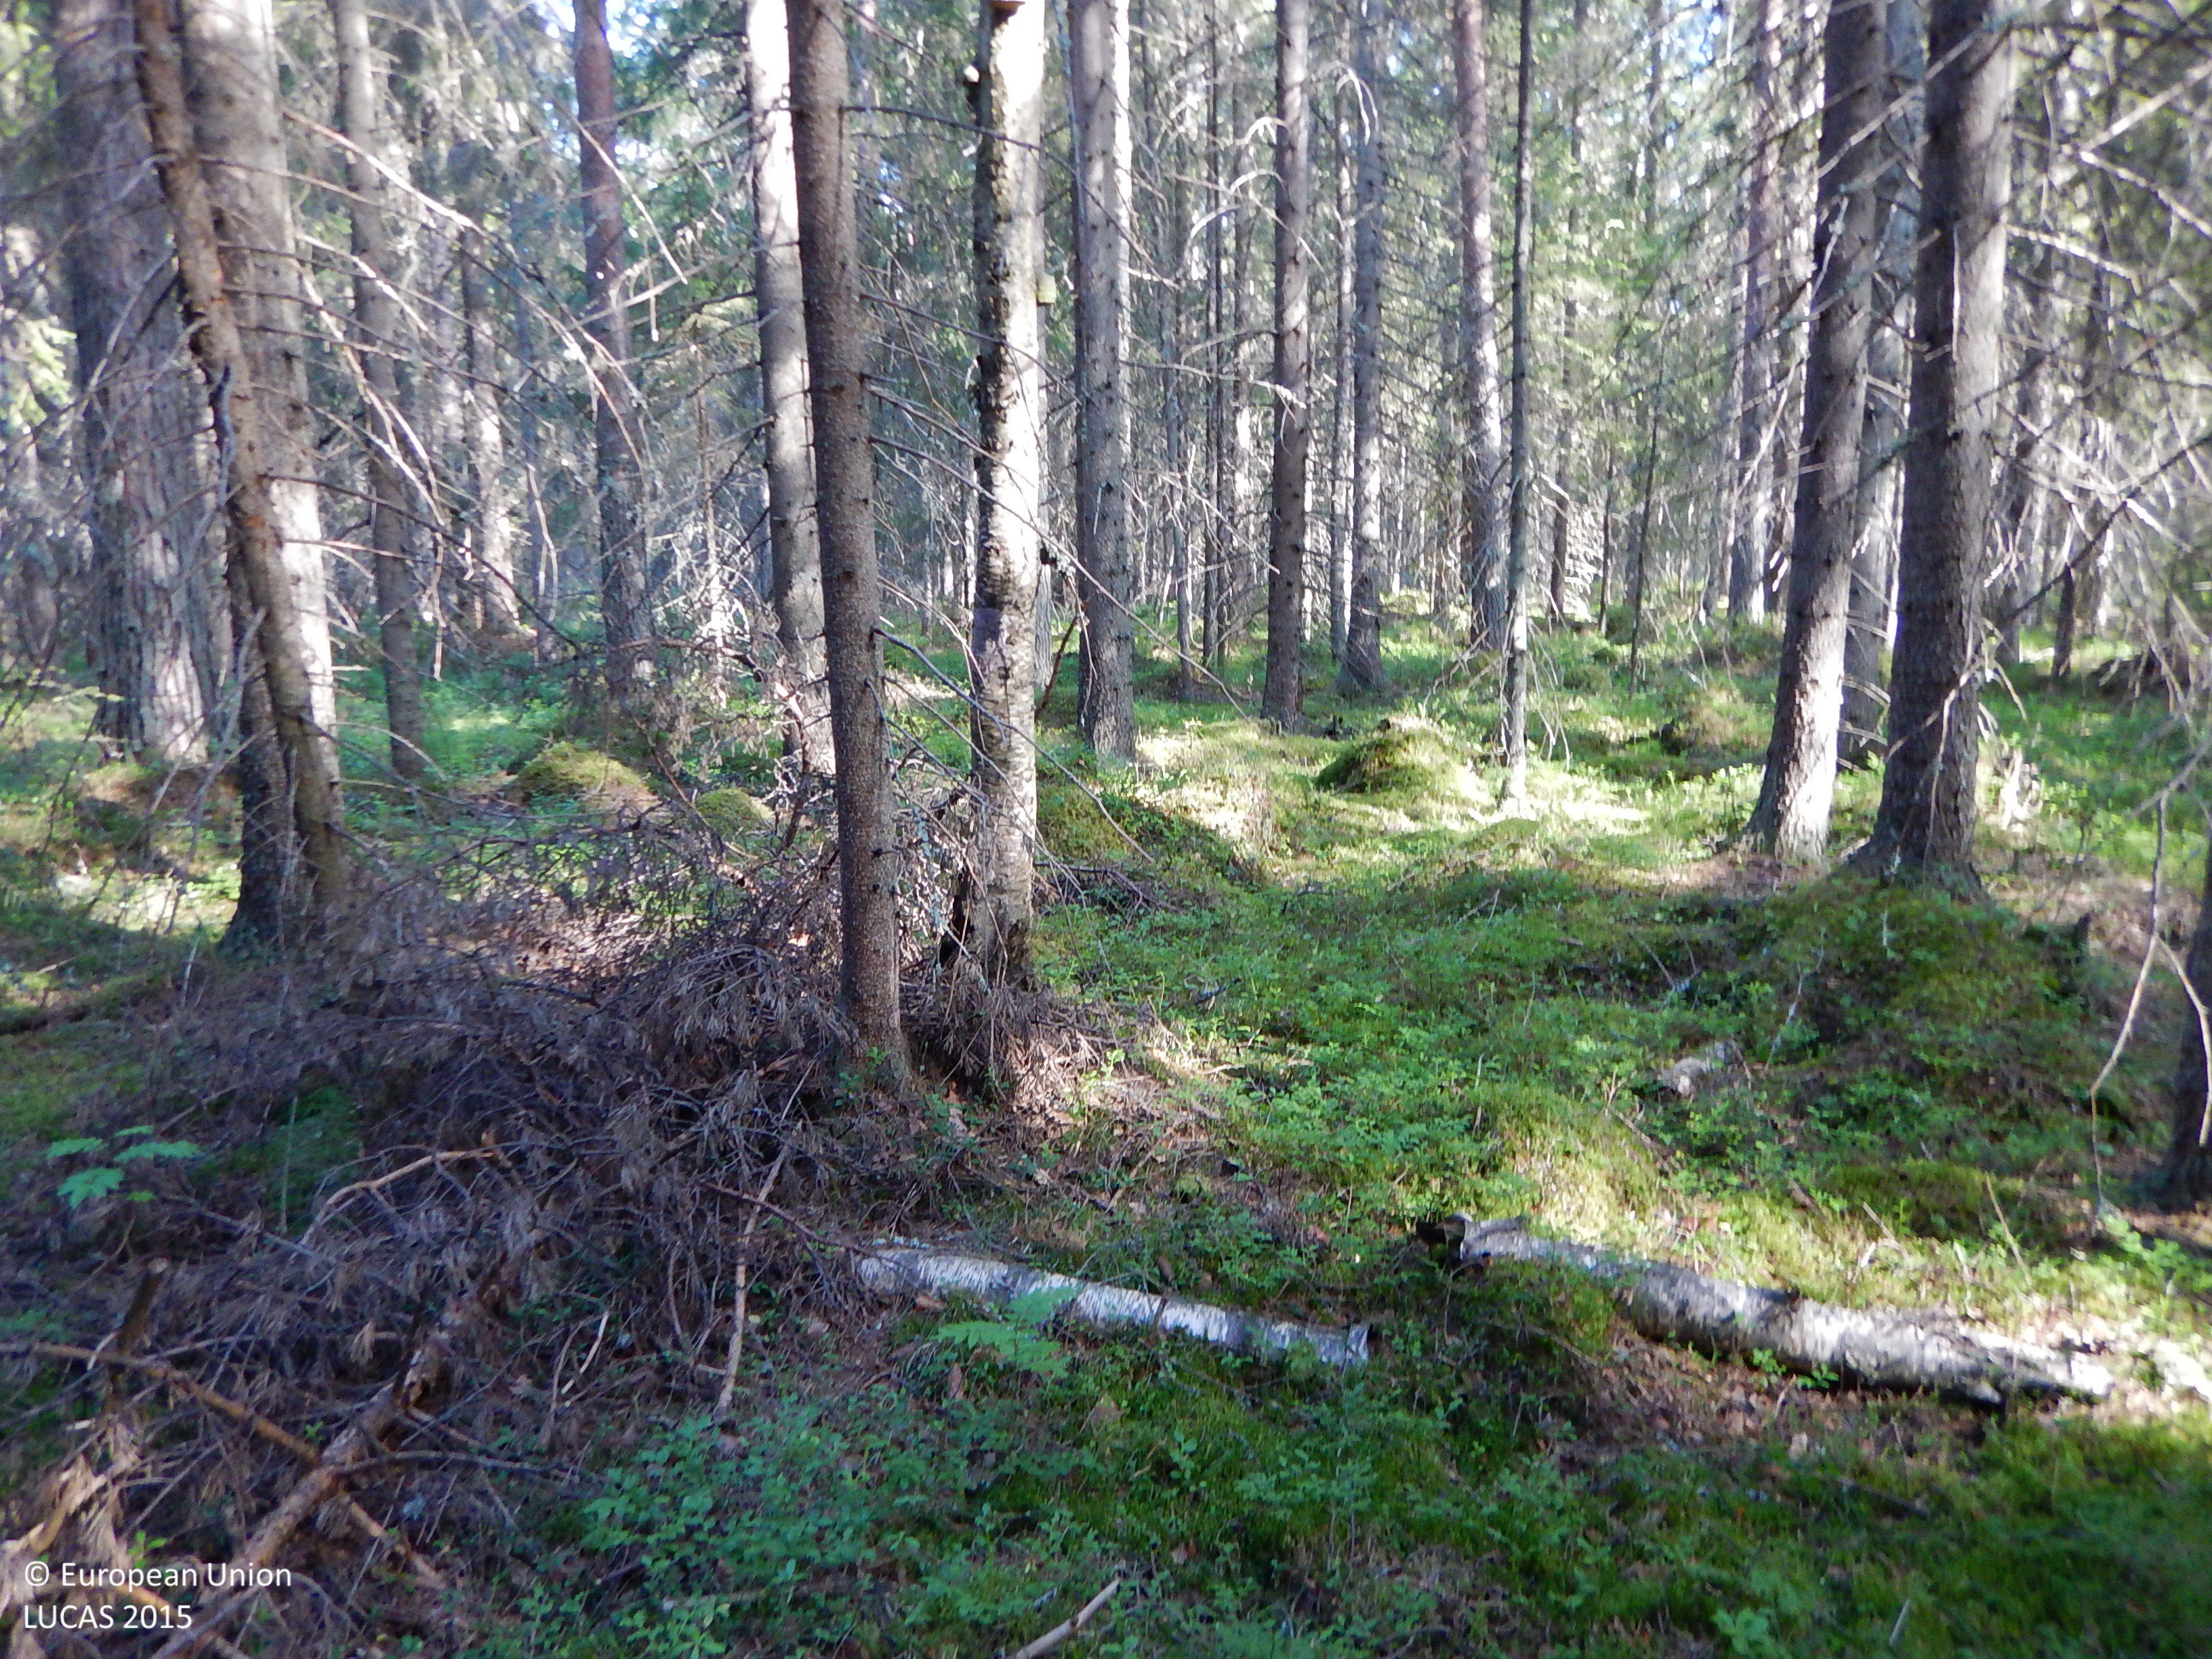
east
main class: Woodland
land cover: Spruce dominated coniferous woodland
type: boreal forest
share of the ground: 50 - 75 %
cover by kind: coniferous forest trees 55 %, lichens and mosses 20 %, broadleaved forest trees 10 %, shrubs 10 %, herbaceous plants 5 %
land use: Forestry
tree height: > 5 m
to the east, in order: Spruce dominated coniferous woodland; Ditches and canals; Pine dominated coniferous woodland; Ditches and canals; Pine dominated coniferous woodland; Tracks; Pine dominated mixed woodland
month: July
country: SE
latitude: 64.8015
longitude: 20.9872
